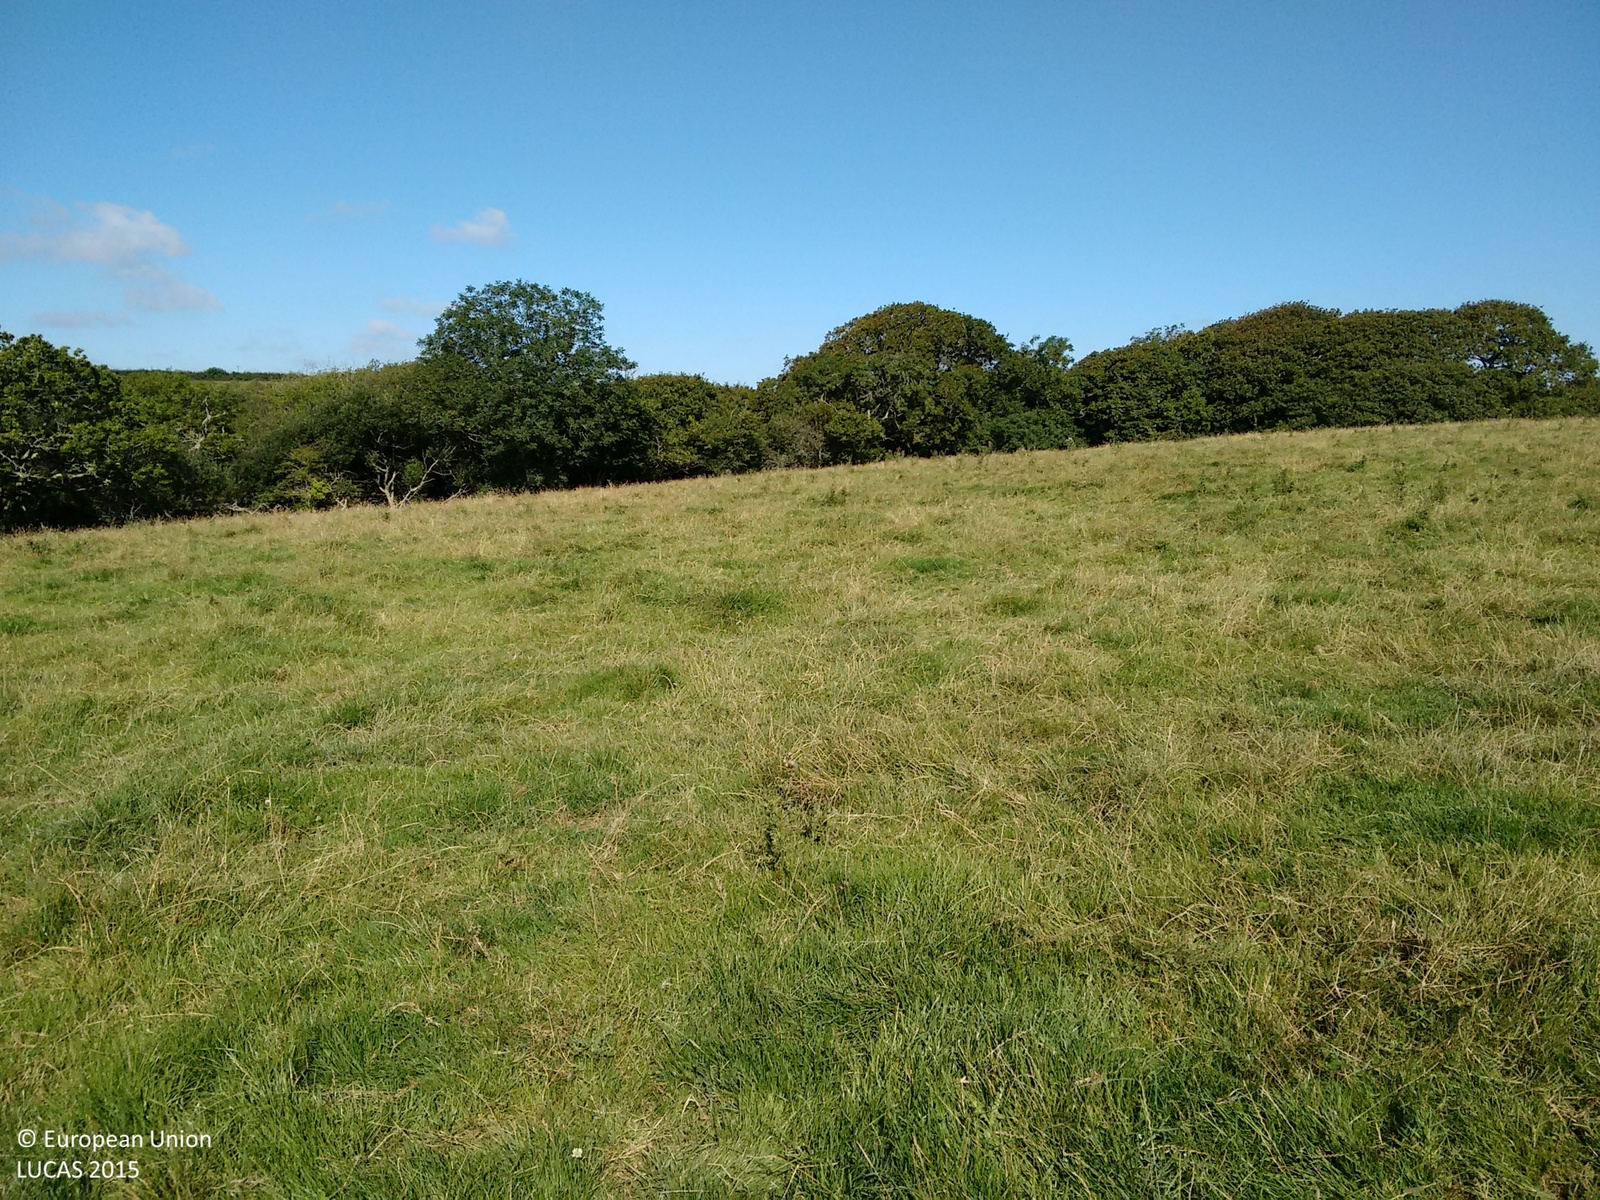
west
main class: Grassland
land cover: Grassland without tree/shrub cover
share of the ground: > 75 %
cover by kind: herbaceous plants 100 %
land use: Agriculture (excluding fallow land and kitchen gardens)
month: August
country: GB
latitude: 51.7443
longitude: -4.8725
